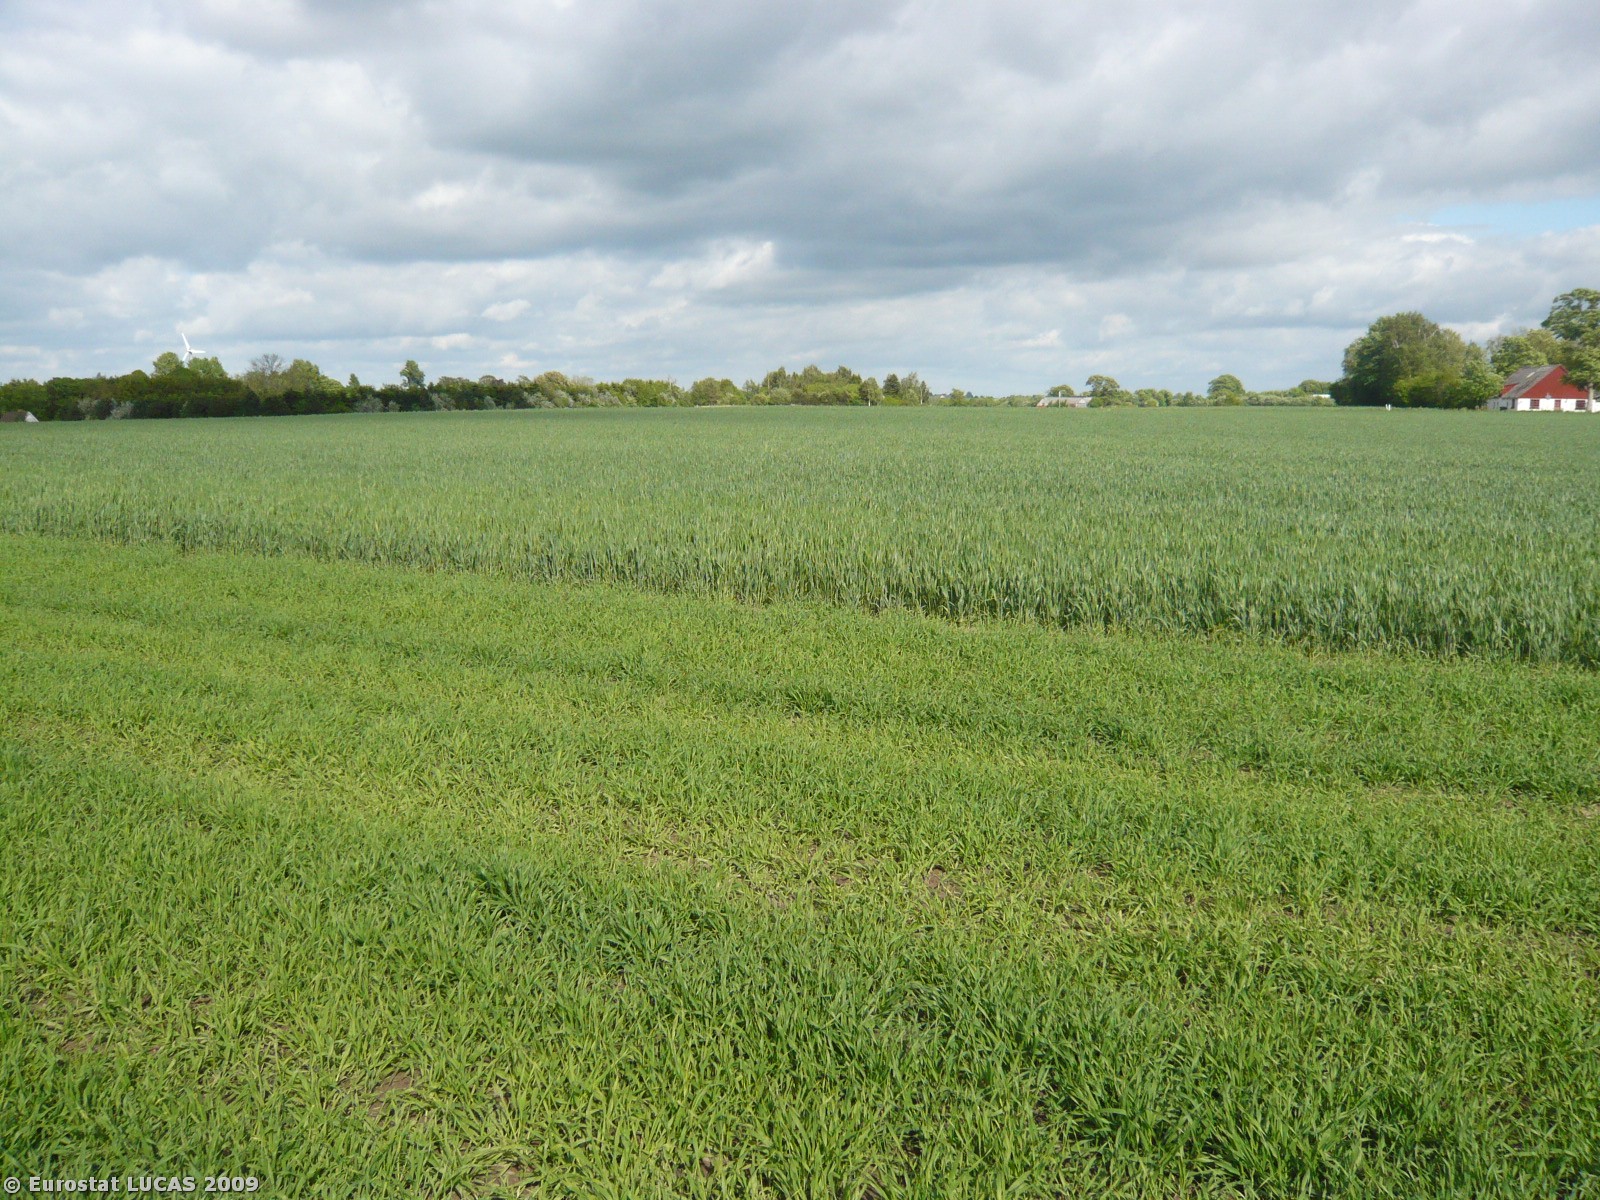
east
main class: Cropland
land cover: Barley
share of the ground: > 75 %
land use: Agriculture (excluding fallow land and kitchen gardens)
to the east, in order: Barley; Common wheat; Grass margins; Paved roads, cycling and walking lanes; Grass margins; Common wheat
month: May
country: DK
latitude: 55.3676
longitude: 11.6868
